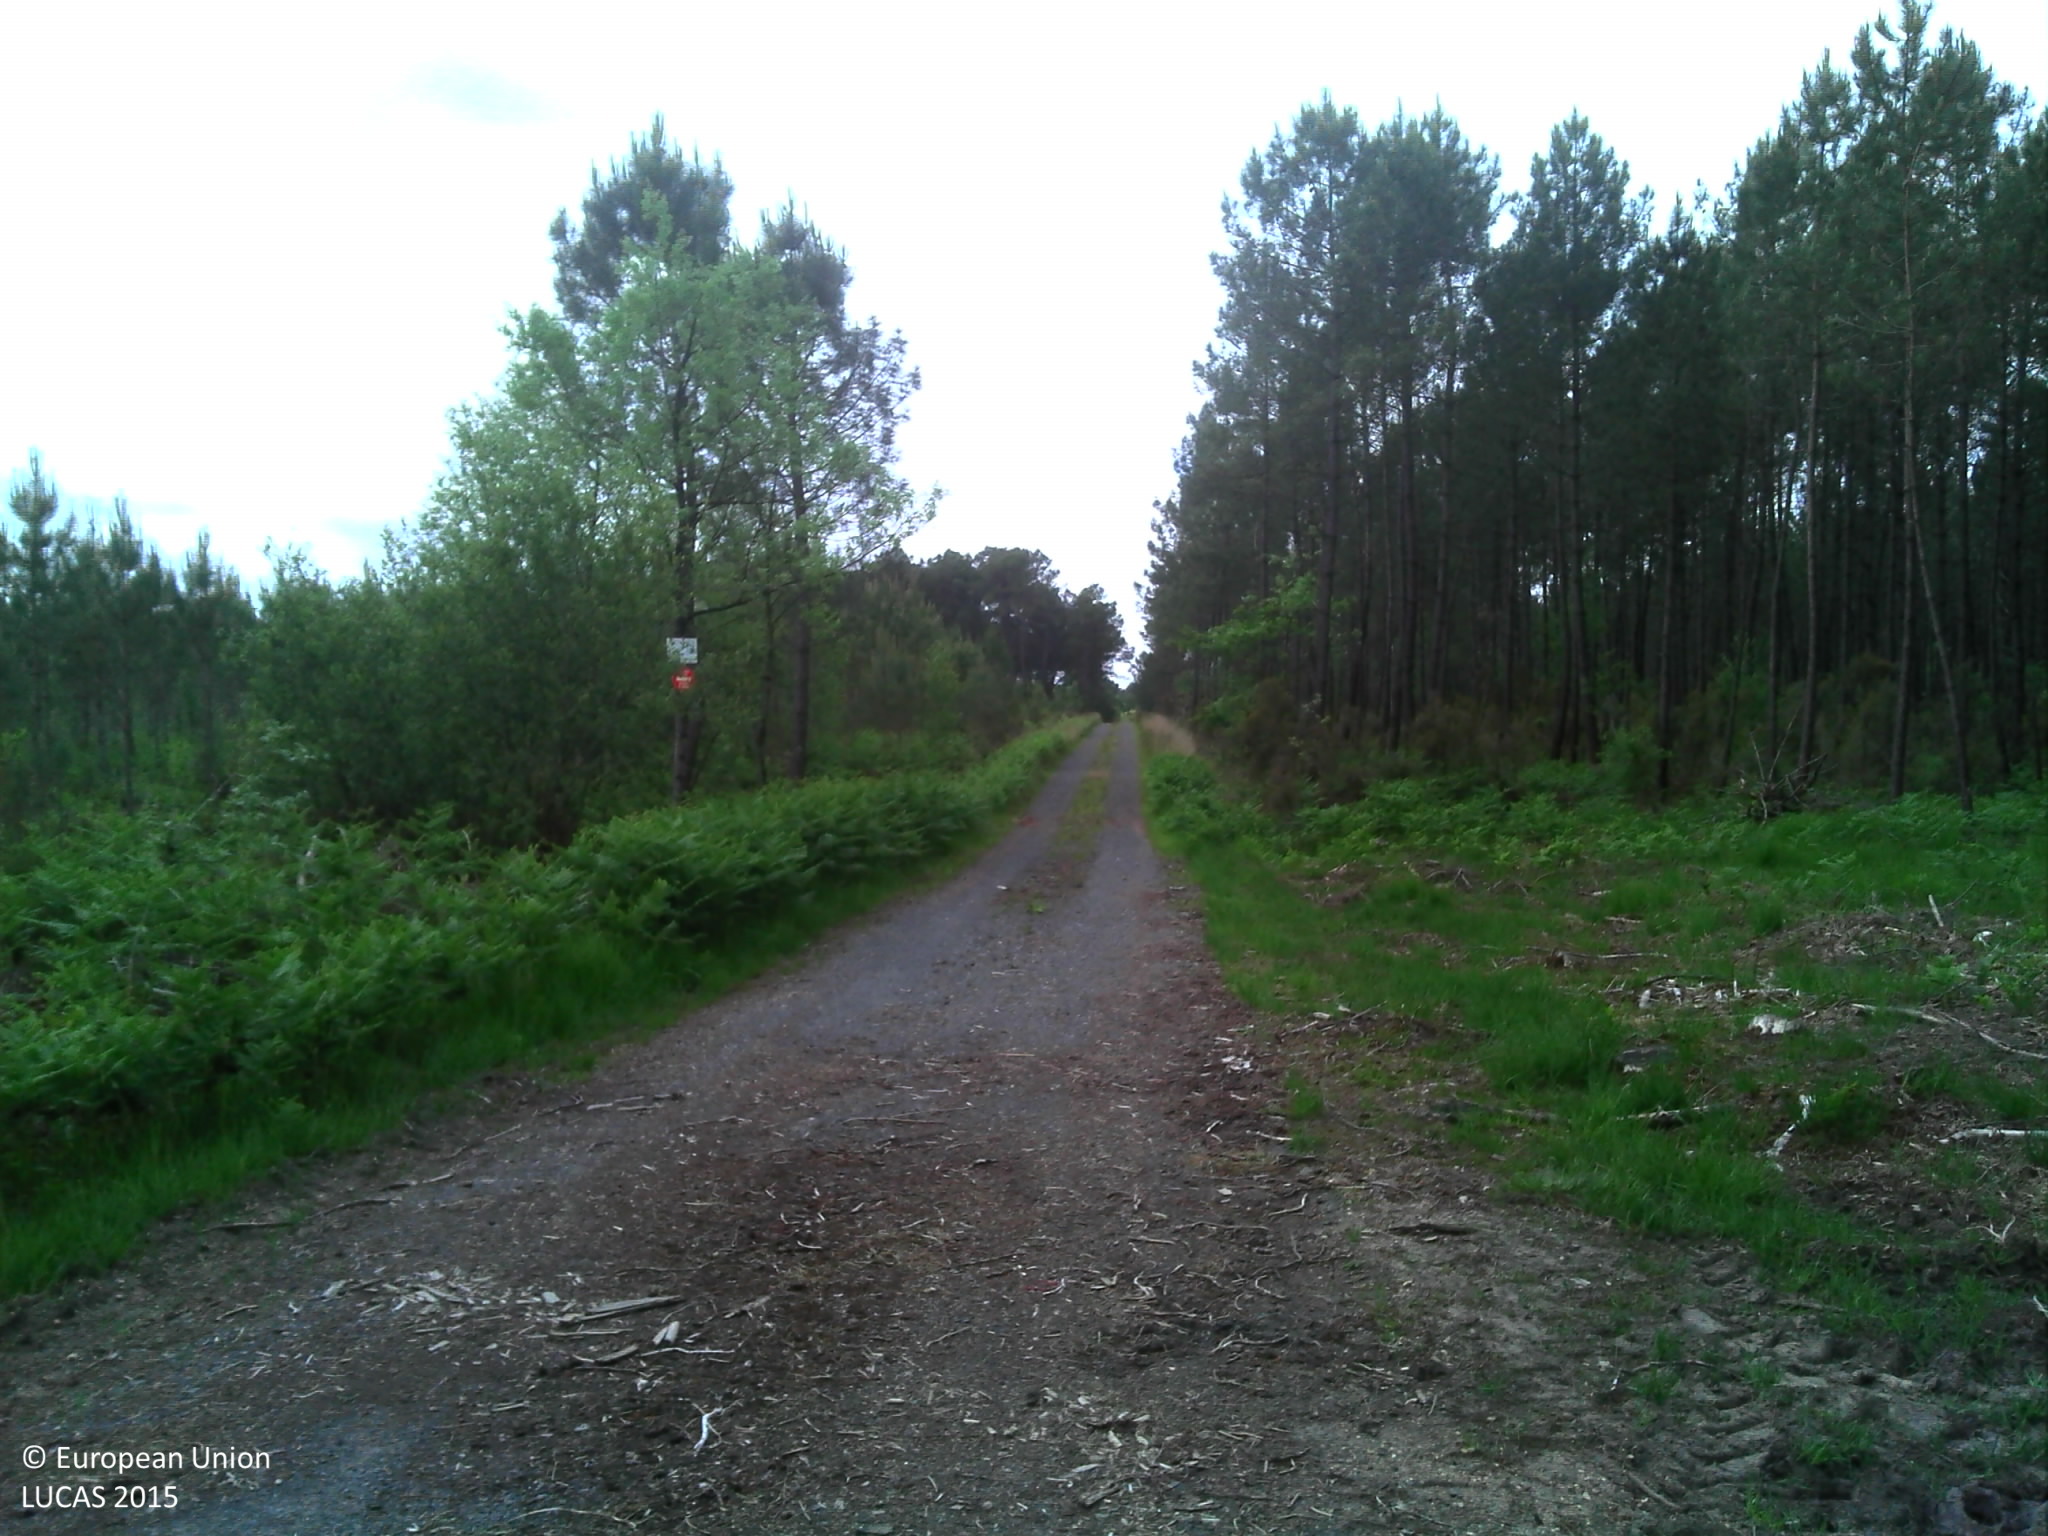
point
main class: Woodland
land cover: Pine dominated mixed woodland
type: hemiboreal forest and nemoral coniferous forest and mixed broadleaved-coniferous forest
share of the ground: > 75 %
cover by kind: coniferous forest trees 55 %, broadleaved forest trees 20 %, herbaceous plants 15 %, lichens and mosses 5 %, consolidated bare surface 5 %
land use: Forestry
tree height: > 5 m
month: June
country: FR
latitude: 47.6209
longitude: -0.0192
